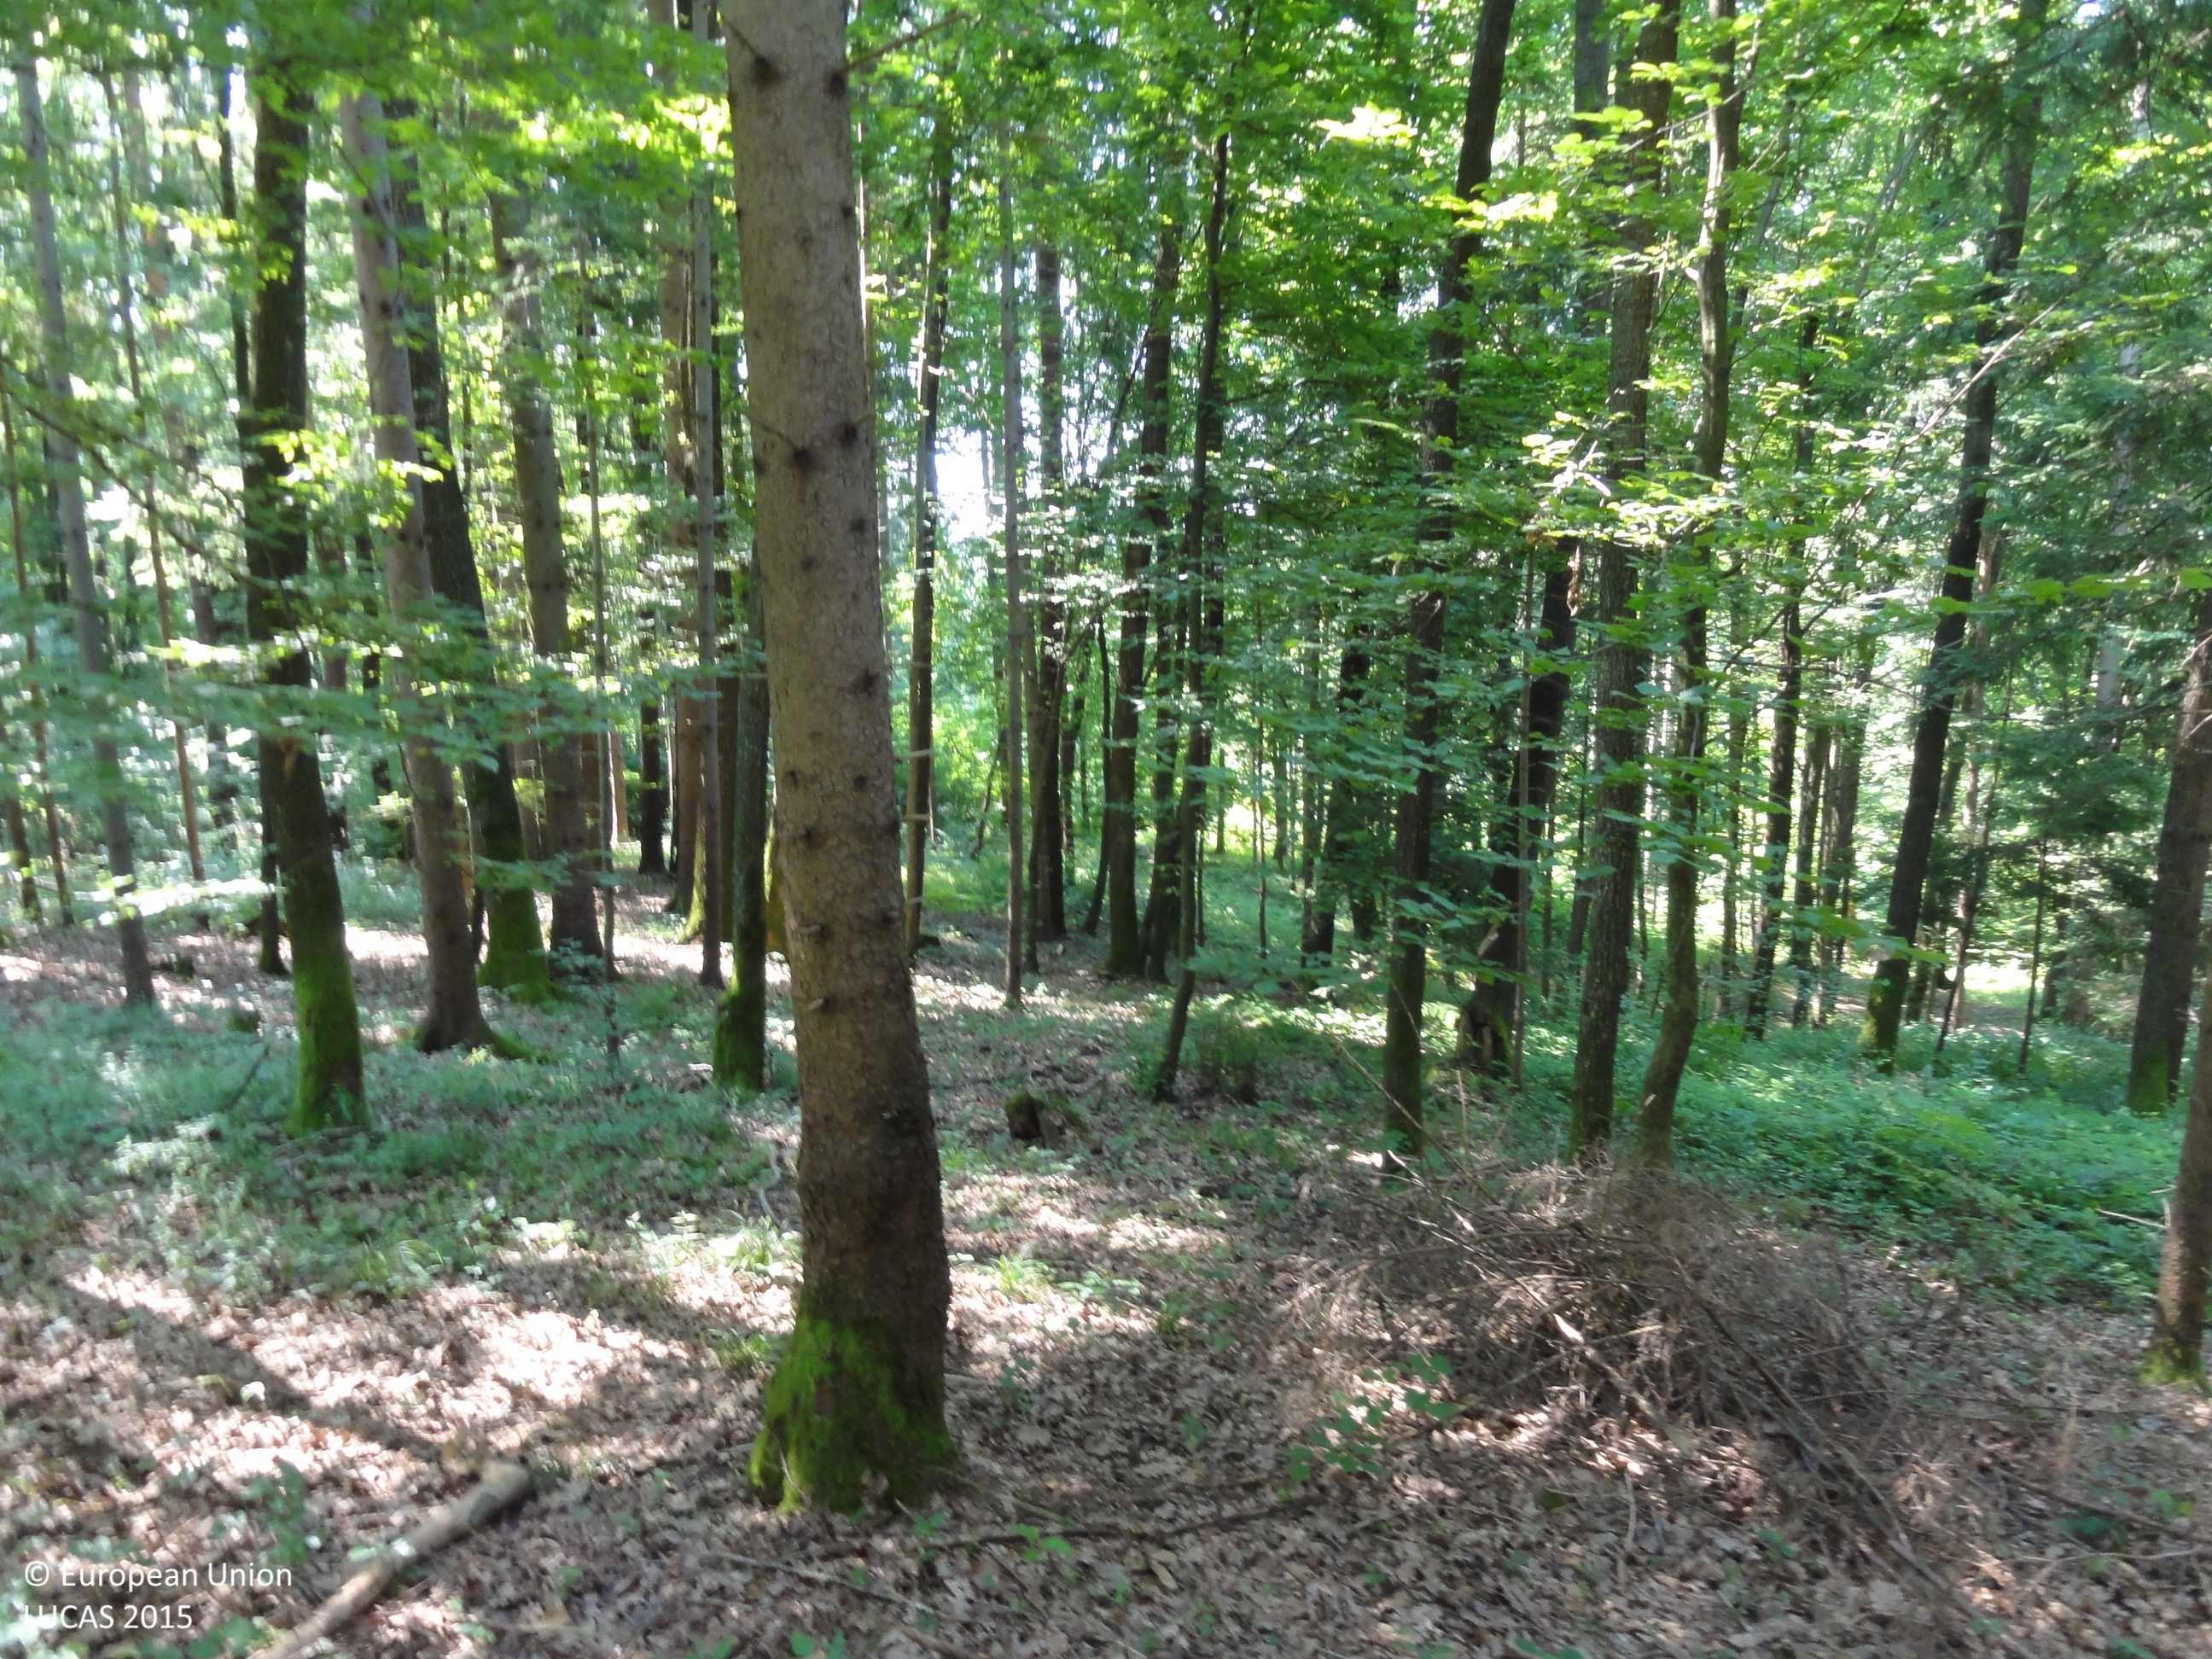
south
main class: Woodland
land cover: Spruce dominated mixed woodland
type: hemiboreal forest and nemoral coniferous forest and mixed broadleaved-coniferous forest
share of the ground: > 75 %
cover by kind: coniferous forest trees 60 %, broadleaved forest trees 40 %
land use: Forestry
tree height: > 5 m
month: July
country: SI
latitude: 46.3889
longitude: 15.5251
